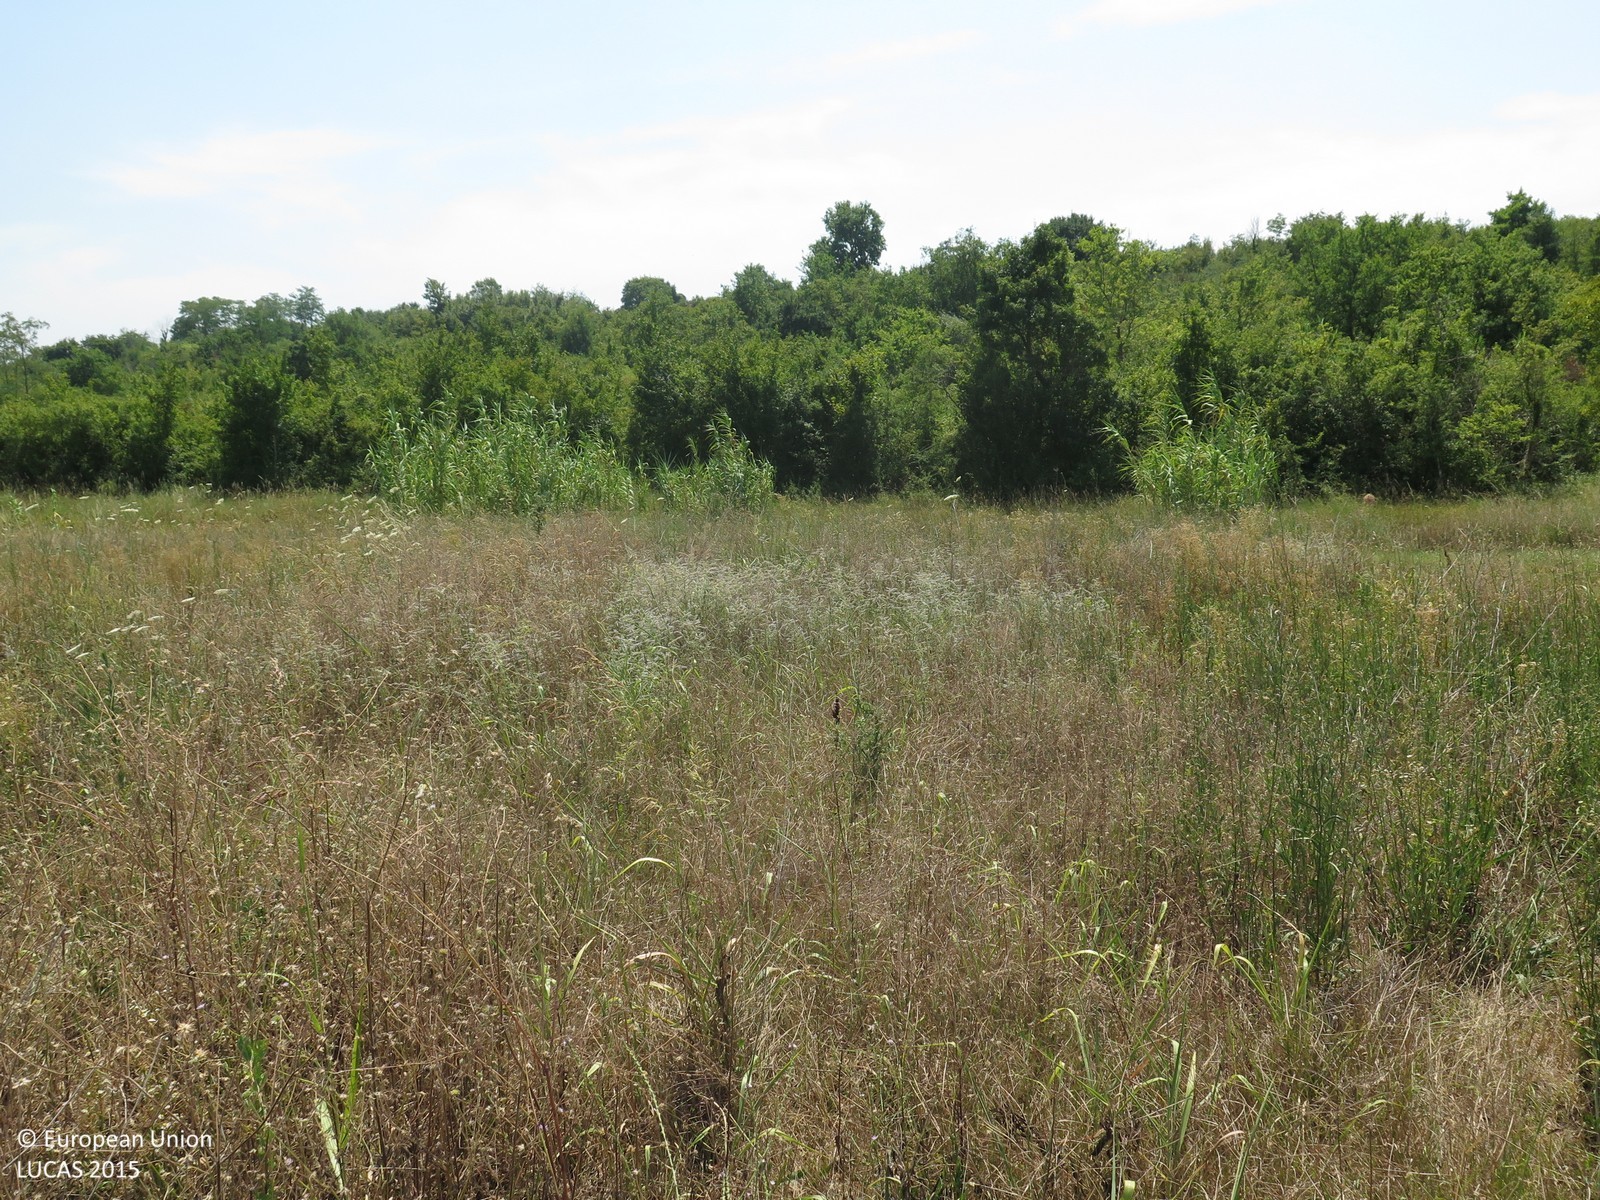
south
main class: Grassland
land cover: Spontaneously vegetated surfaces
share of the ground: > 75 %
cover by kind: herbaceous plants 95 %, shrubs 5 %
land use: Fallow land
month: July
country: HR
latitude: 45.4057
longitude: 13.6365
